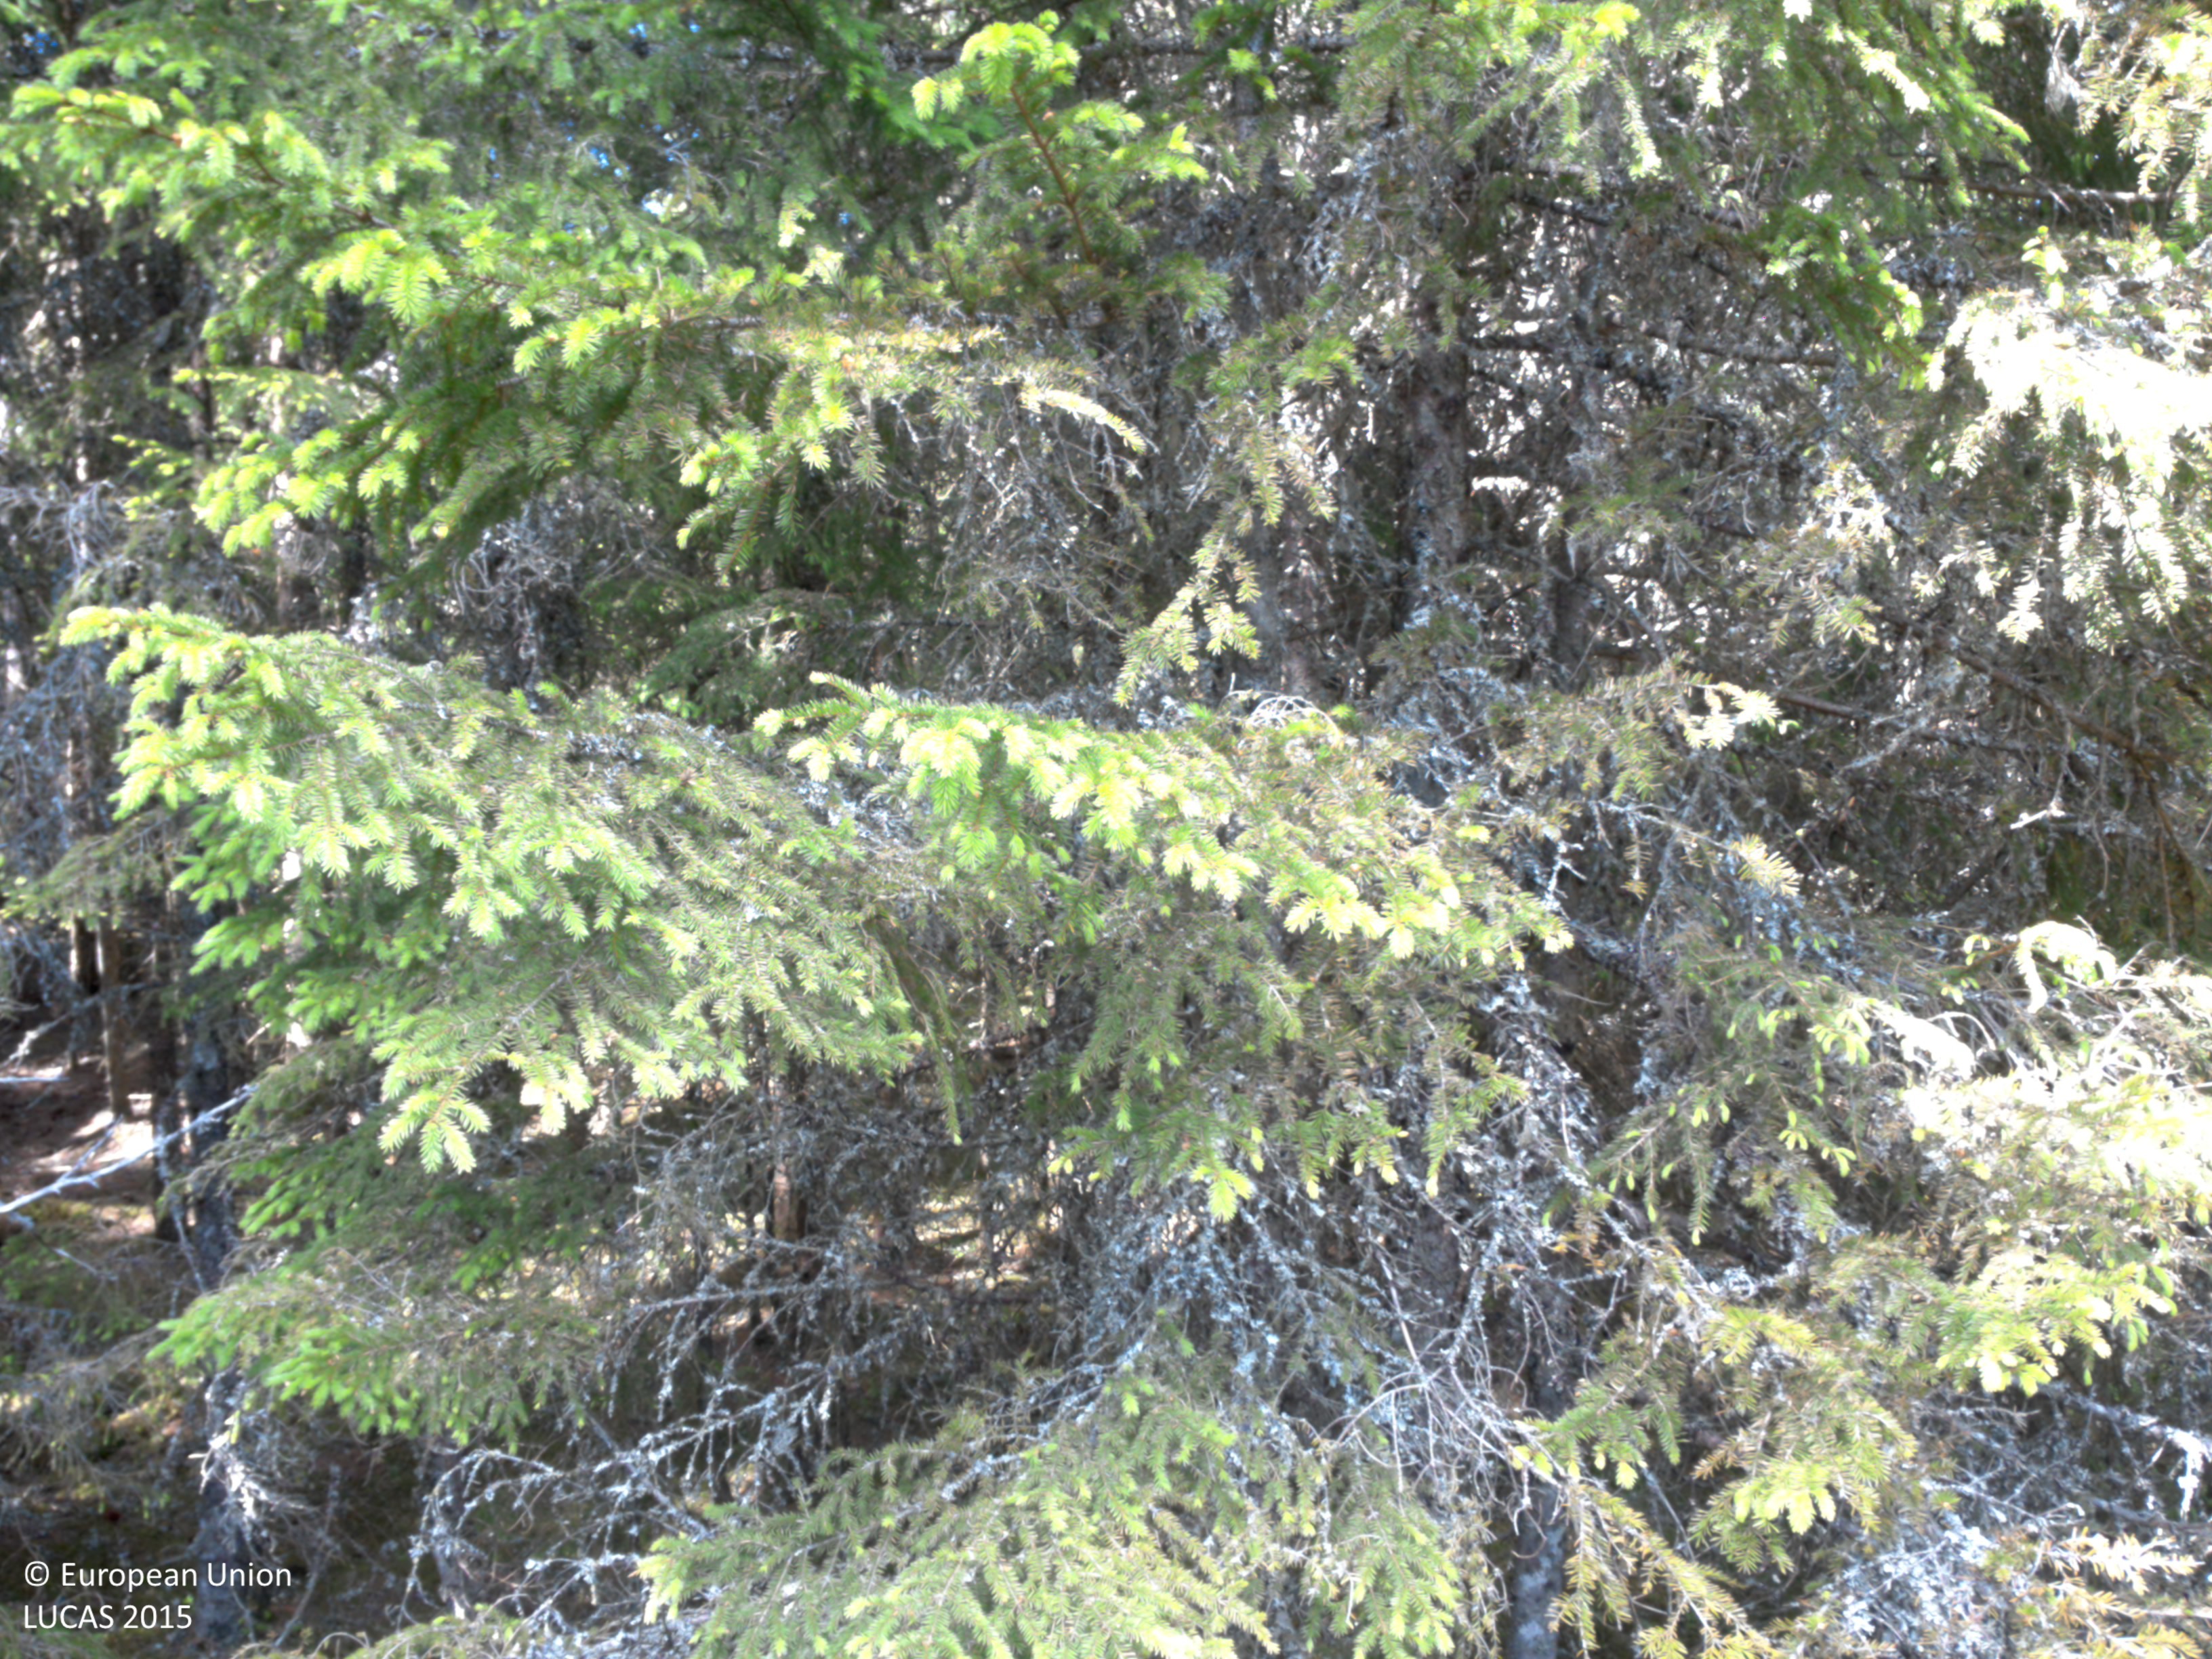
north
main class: Woodland
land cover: Spruce dominated coniferous woodland
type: boreal forest
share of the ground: 25 - 50 %
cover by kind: coniferous forest trees 40 %, shrubs 30 %, lichens and mosses 25 %, herbaceous plants 5 %
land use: Forestry
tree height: > 5 m
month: June
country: SE
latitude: 59.0678
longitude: 12.0358
